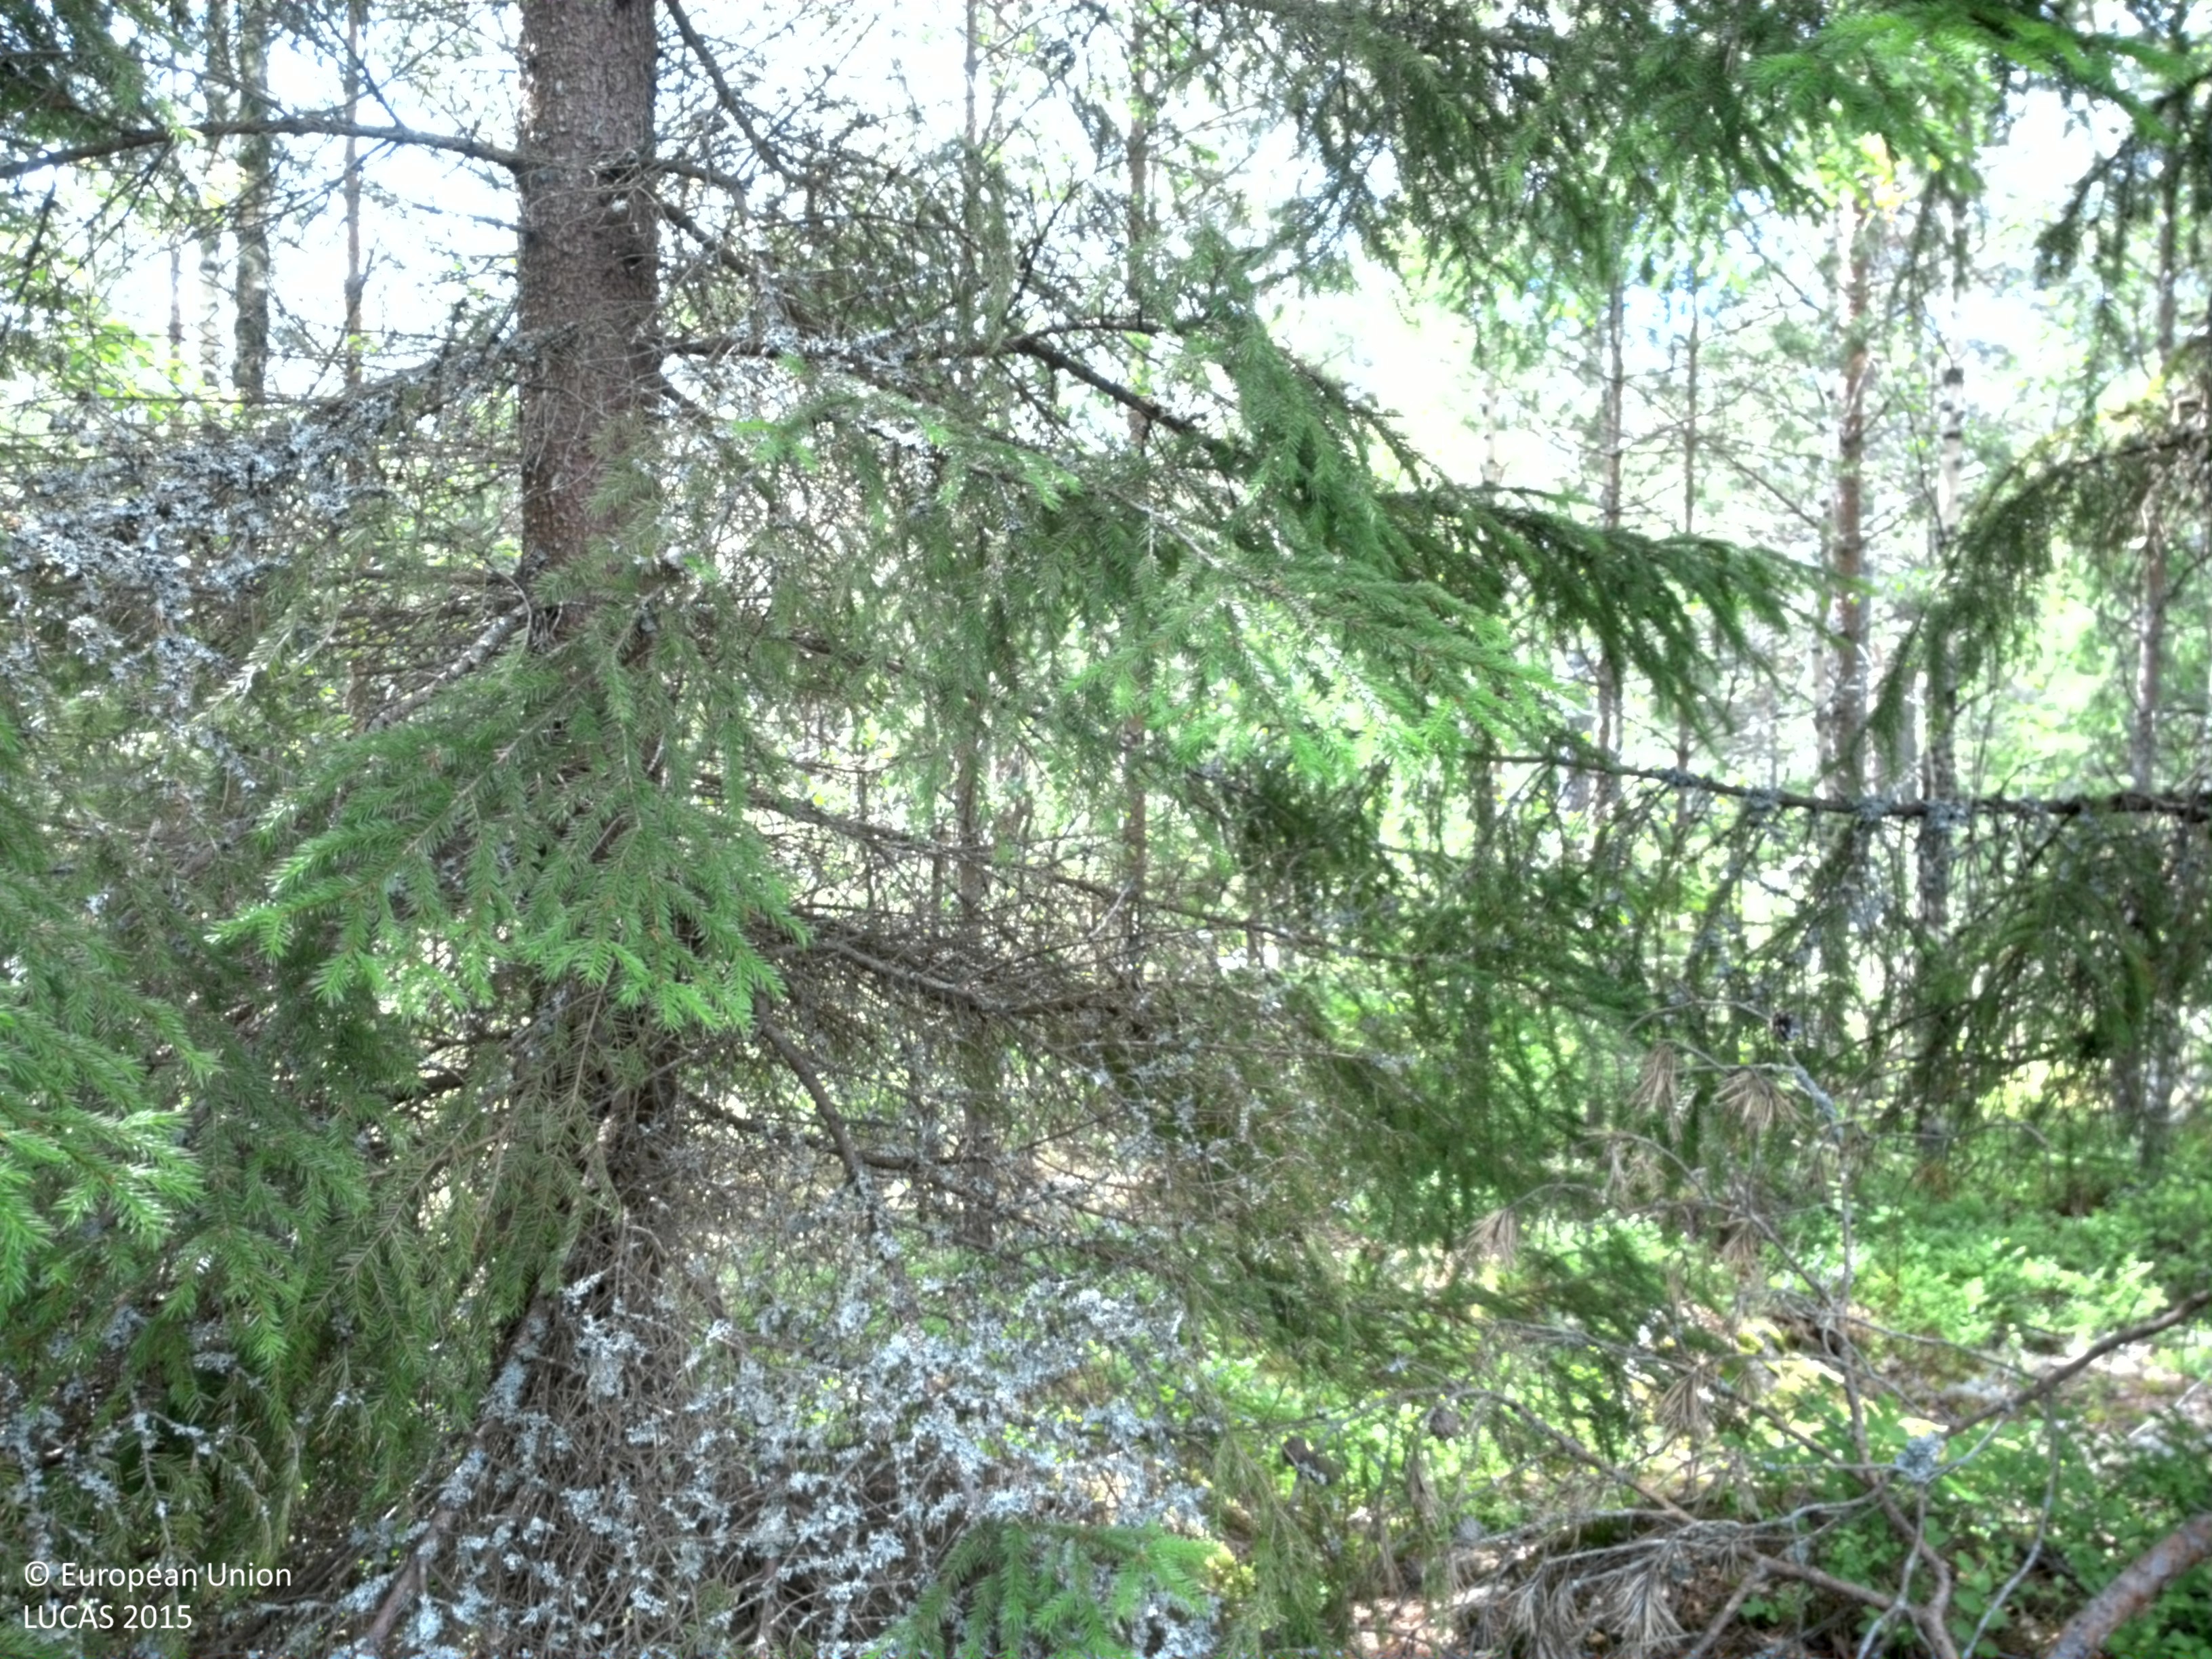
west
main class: Woodland
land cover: Pine dominated mixed woodland
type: boreal forest
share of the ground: 50 - 75 %
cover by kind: coniferous forest trees 40 %, herbaceous plants 35 %, broadleaved forest trees 15 %, lichens and mosses 10 %
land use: Forestry
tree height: > 5 m
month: June
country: SE
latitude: 58.6056
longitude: 15.6564
